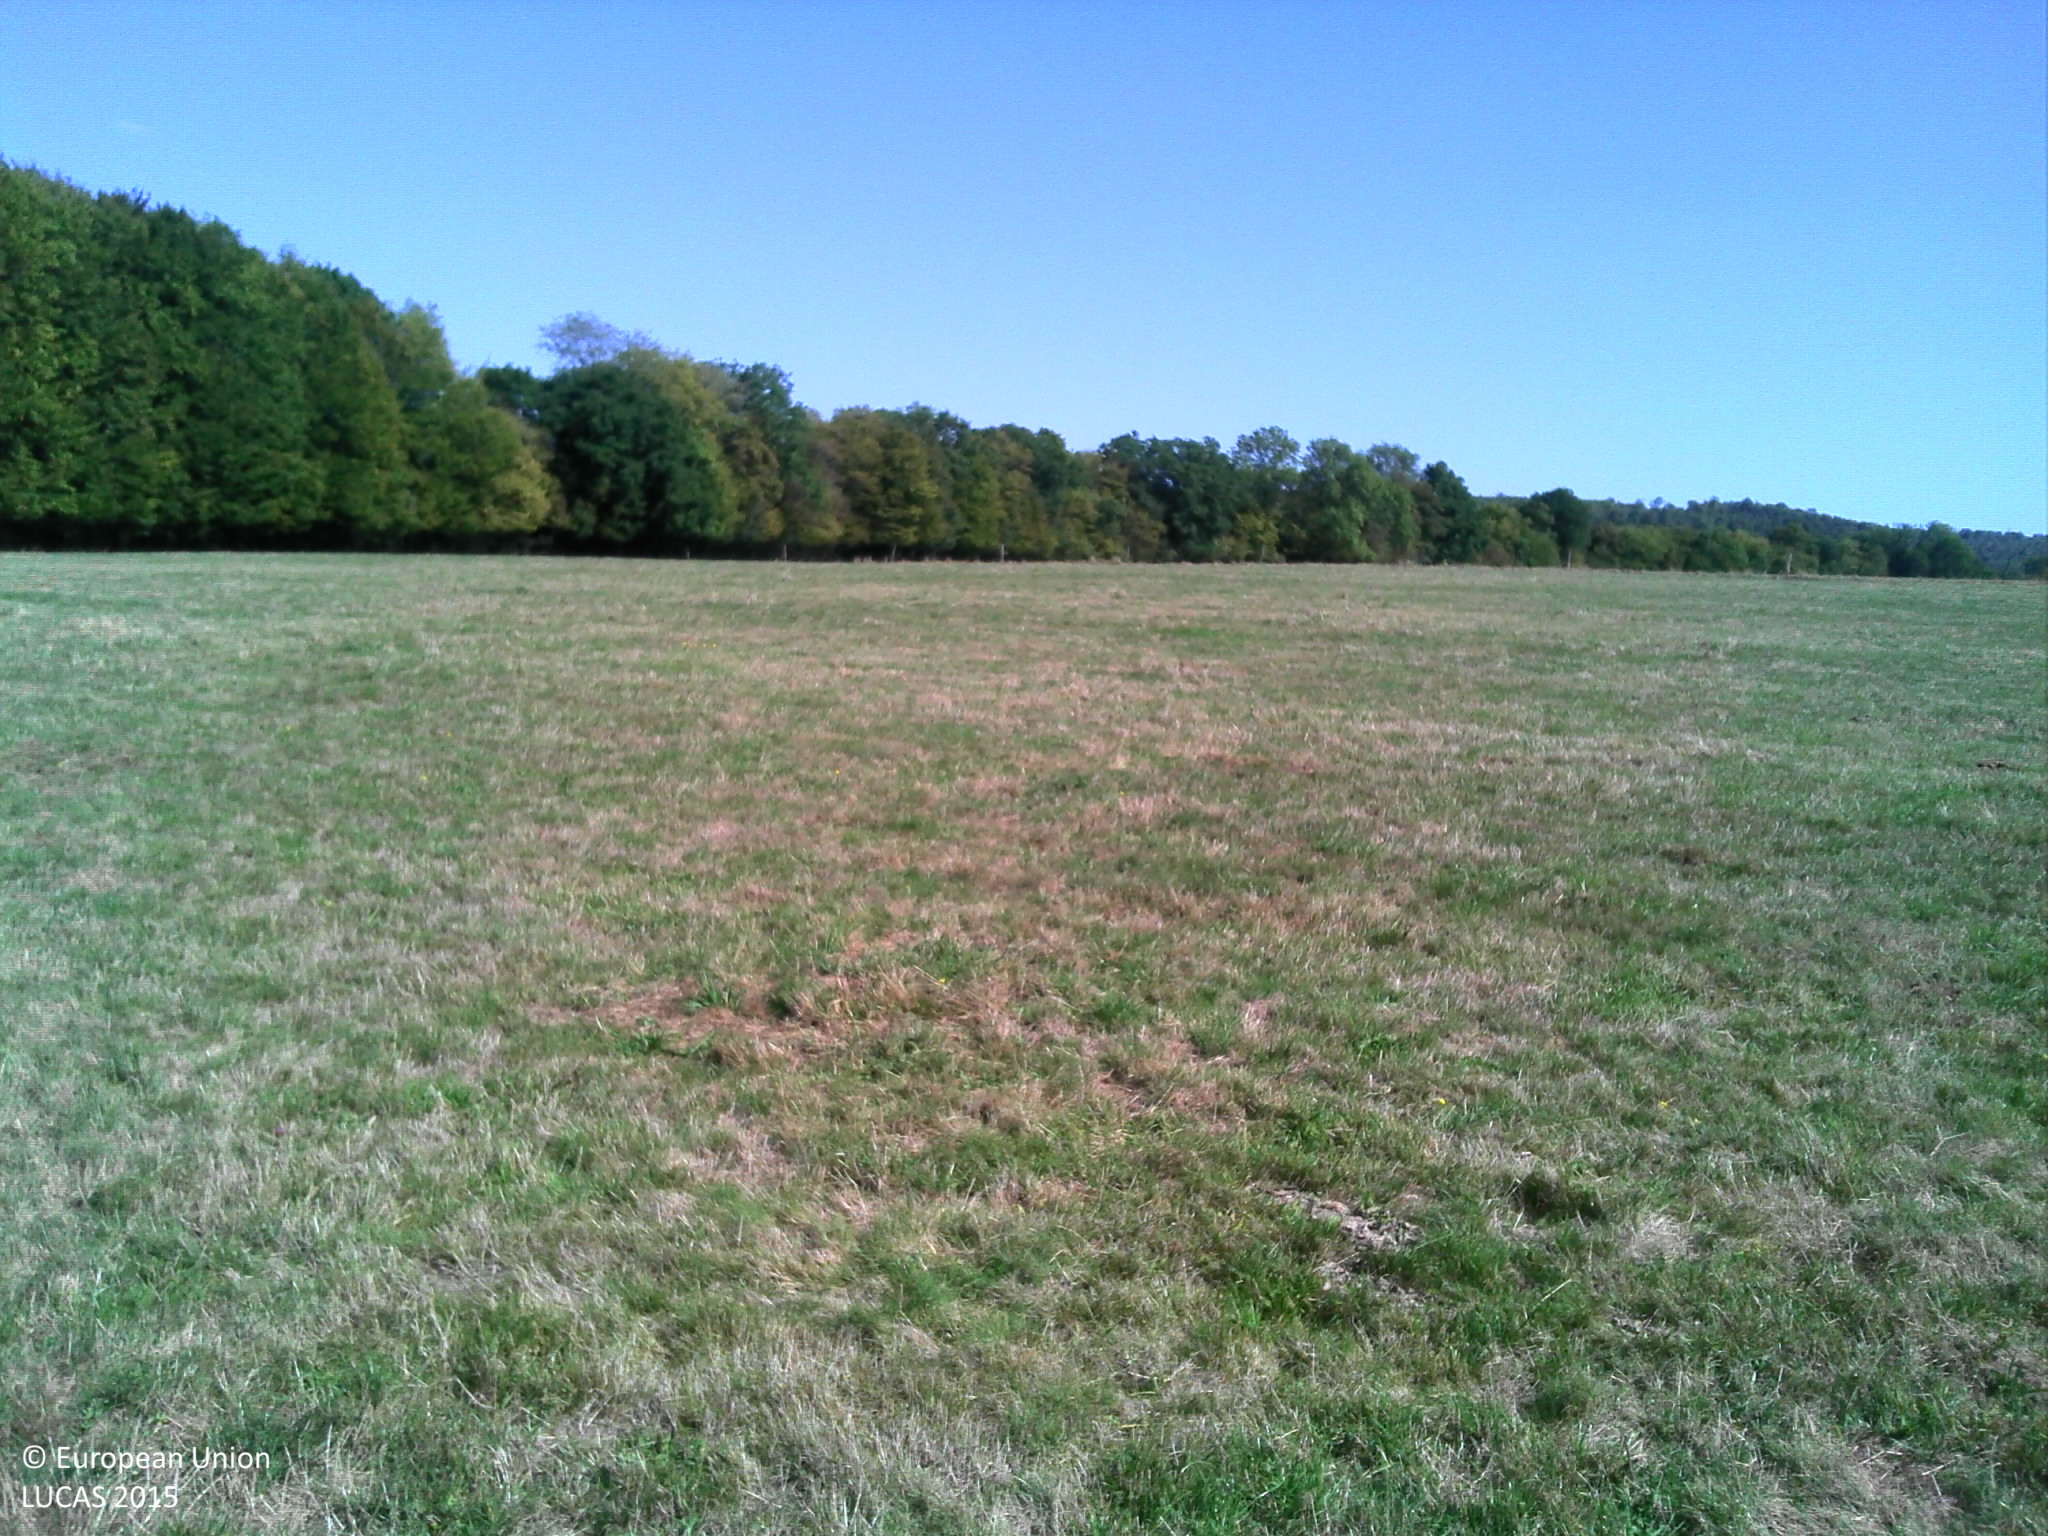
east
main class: Grassland
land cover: Grassland without tree/shrub cover
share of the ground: > 75 %
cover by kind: herbaceous plants 85 %, consolidated bare surface 15 %
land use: Agriculture (excluding fallow land and kitchen gardens)
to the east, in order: Grassland without tree/shrub cover; Fences; Grassland without tree/shrub cover; Fences; Broadleaved woodland
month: September
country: FR
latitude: 48.6562
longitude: 6.0222
